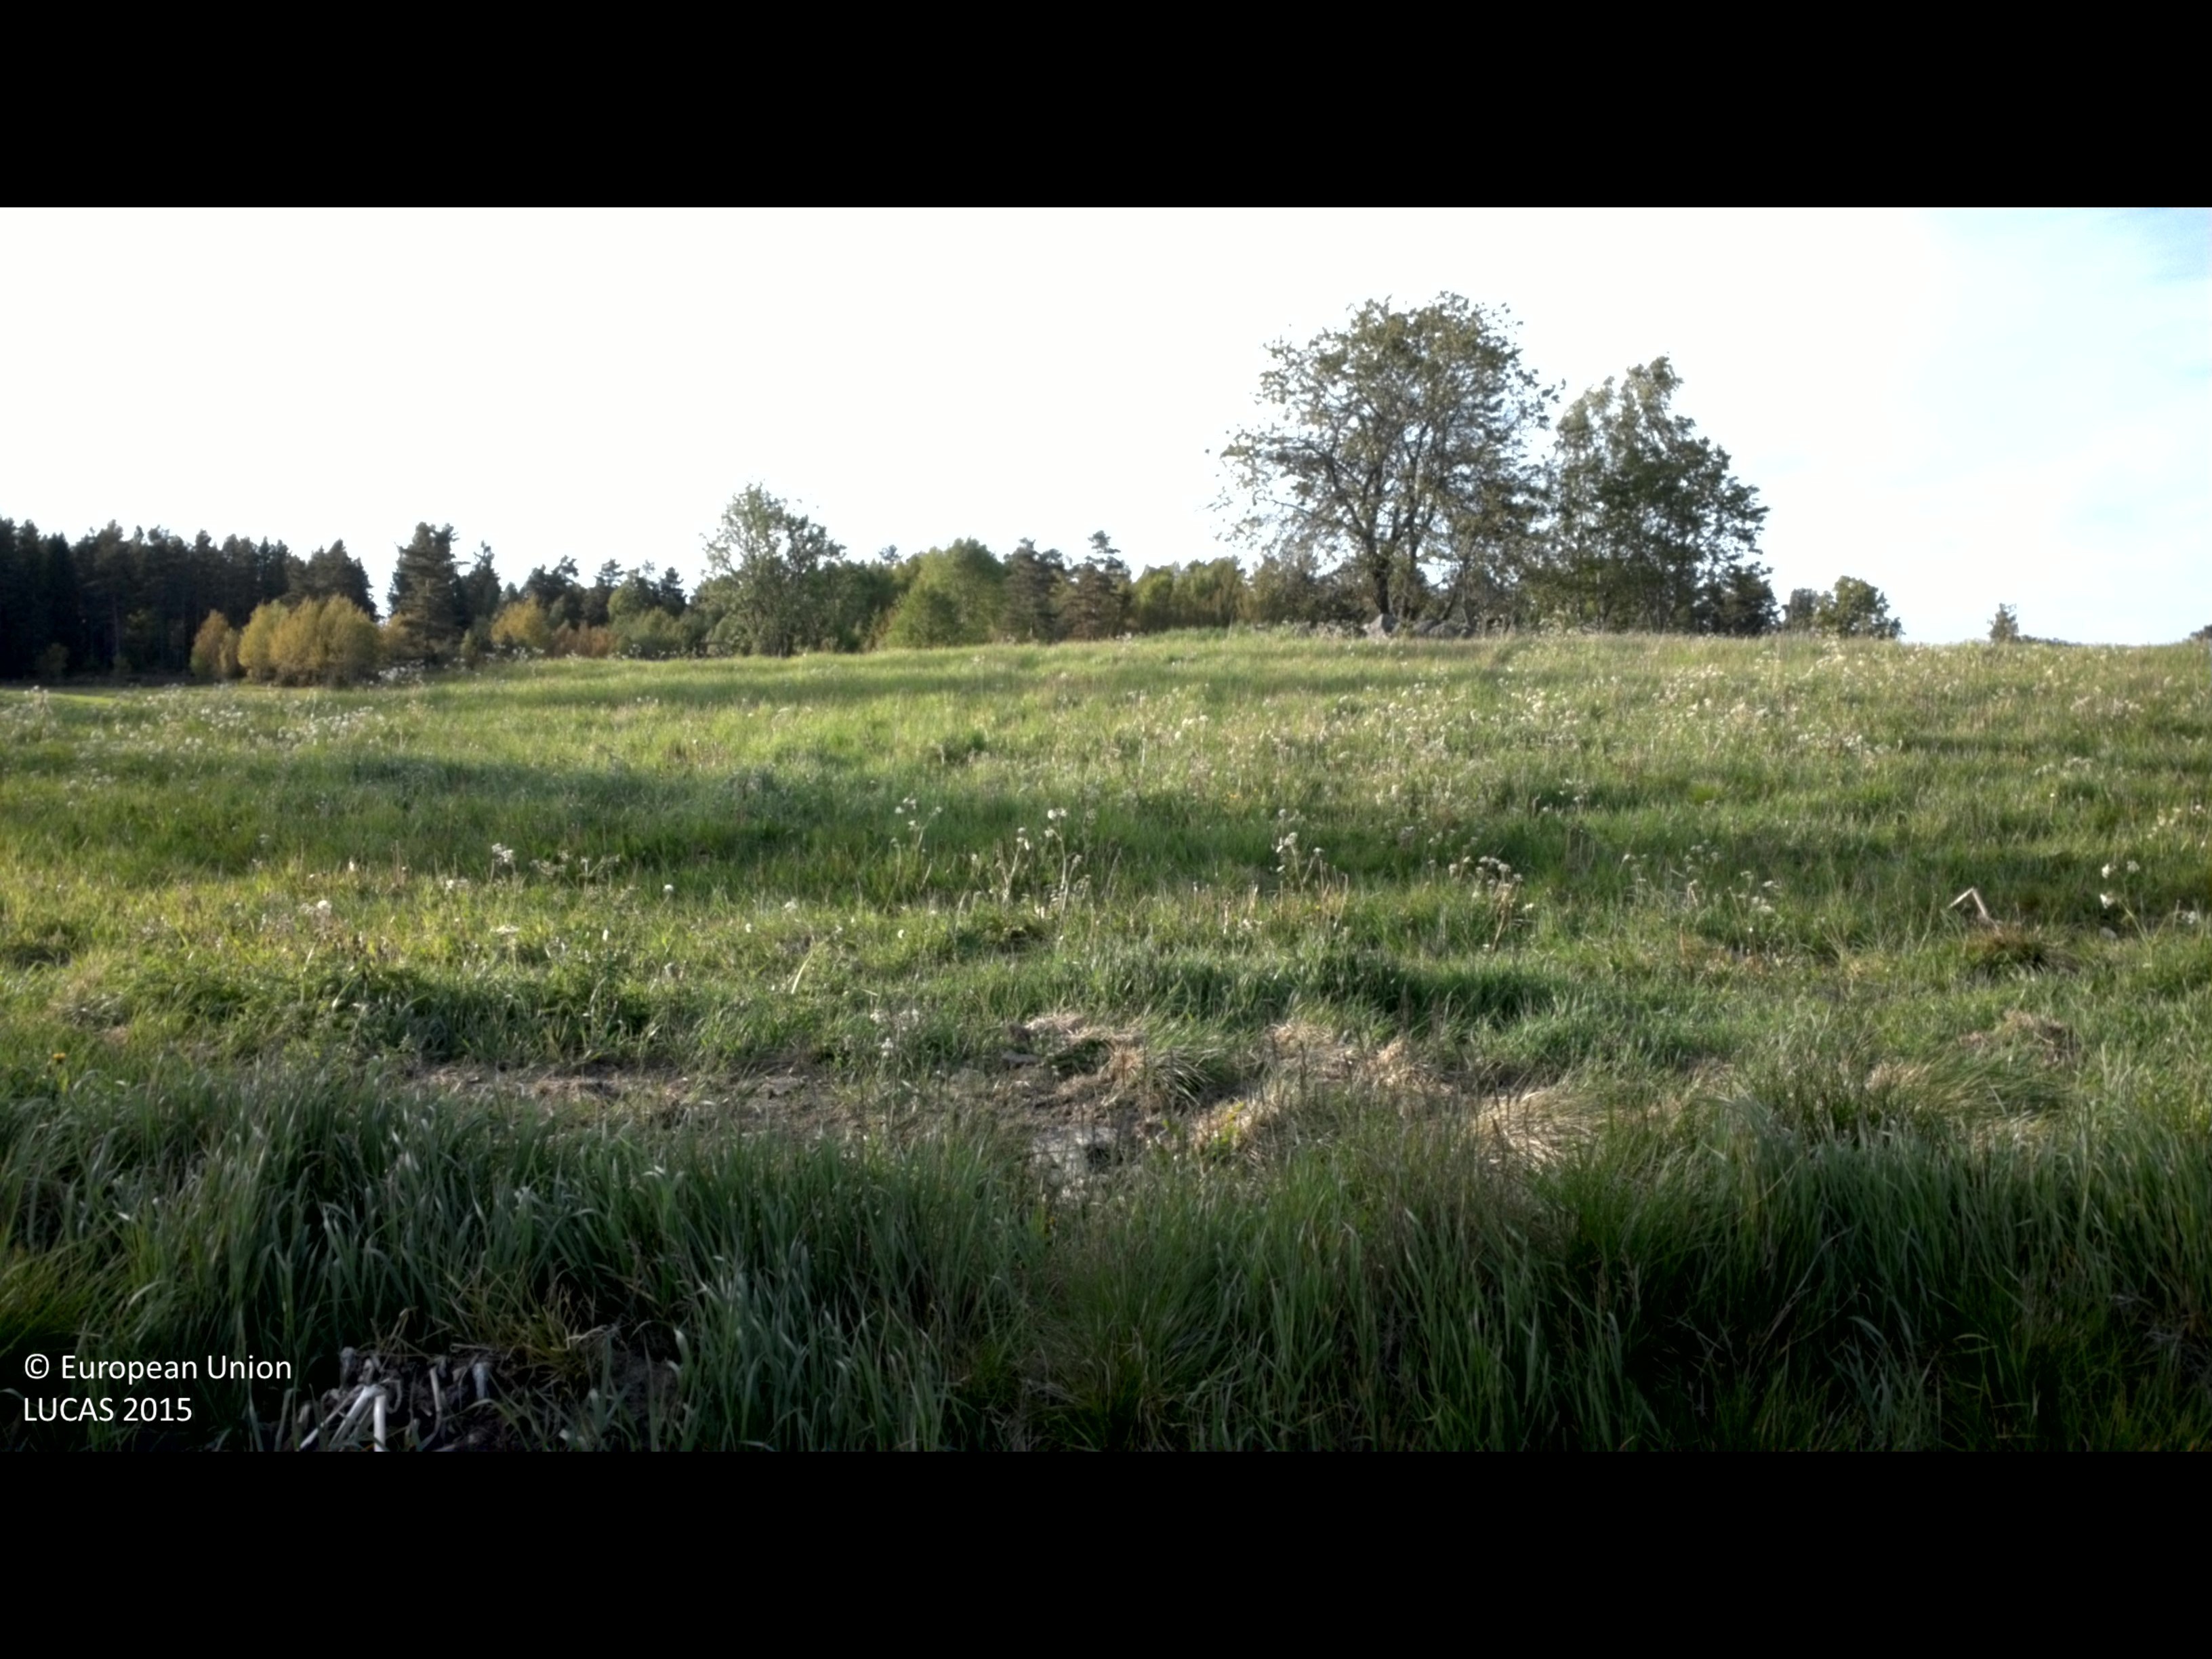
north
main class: Grassland
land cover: Grassland without tree/shrub cover
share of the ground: > 75 %
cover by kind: herbaceous plants 100 %
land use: Agriculture (excluding fallow land and kitchen gardens)
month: June
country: SE
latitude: 57.6443
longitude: 16.1799
